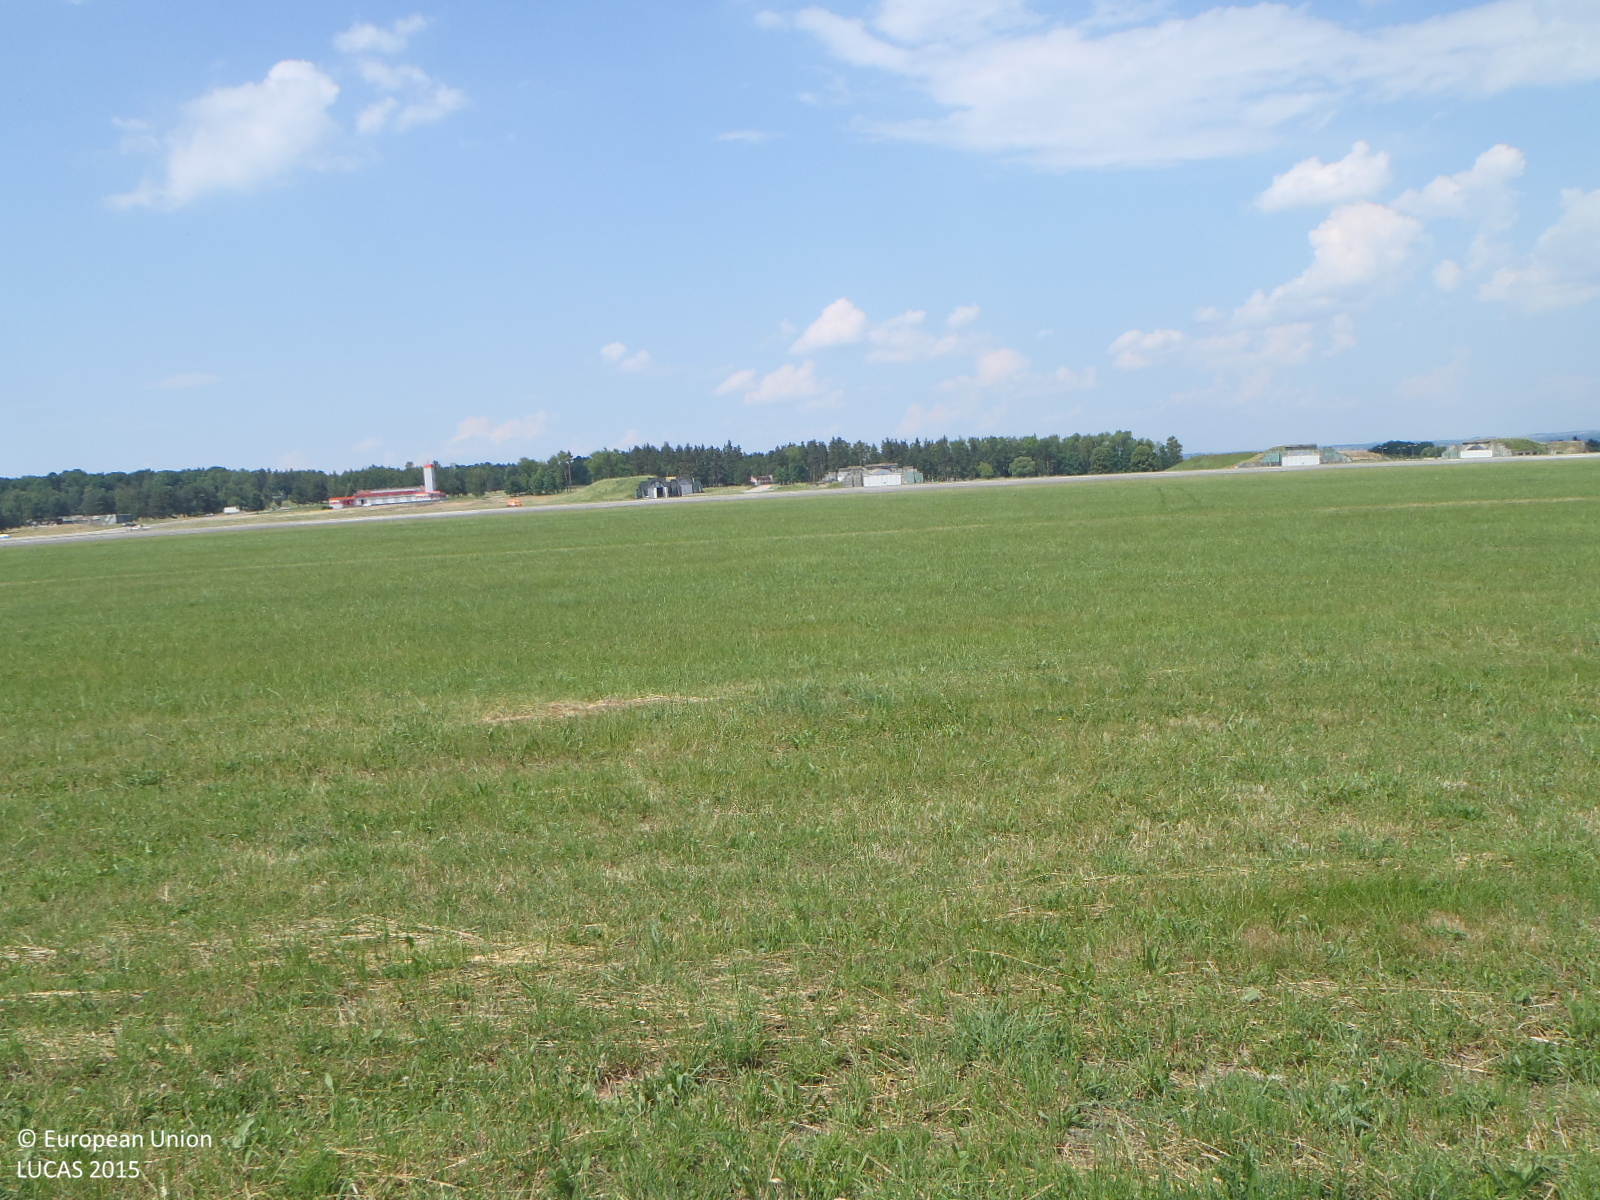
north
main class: Grassland
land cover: Grassland without tree/shrub cover
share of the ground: > 75 %
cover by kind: herbaceous plants 100 %
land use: Air transport
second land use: Community services
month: June
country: CZ
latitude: 48.9451
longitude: 14.4385
